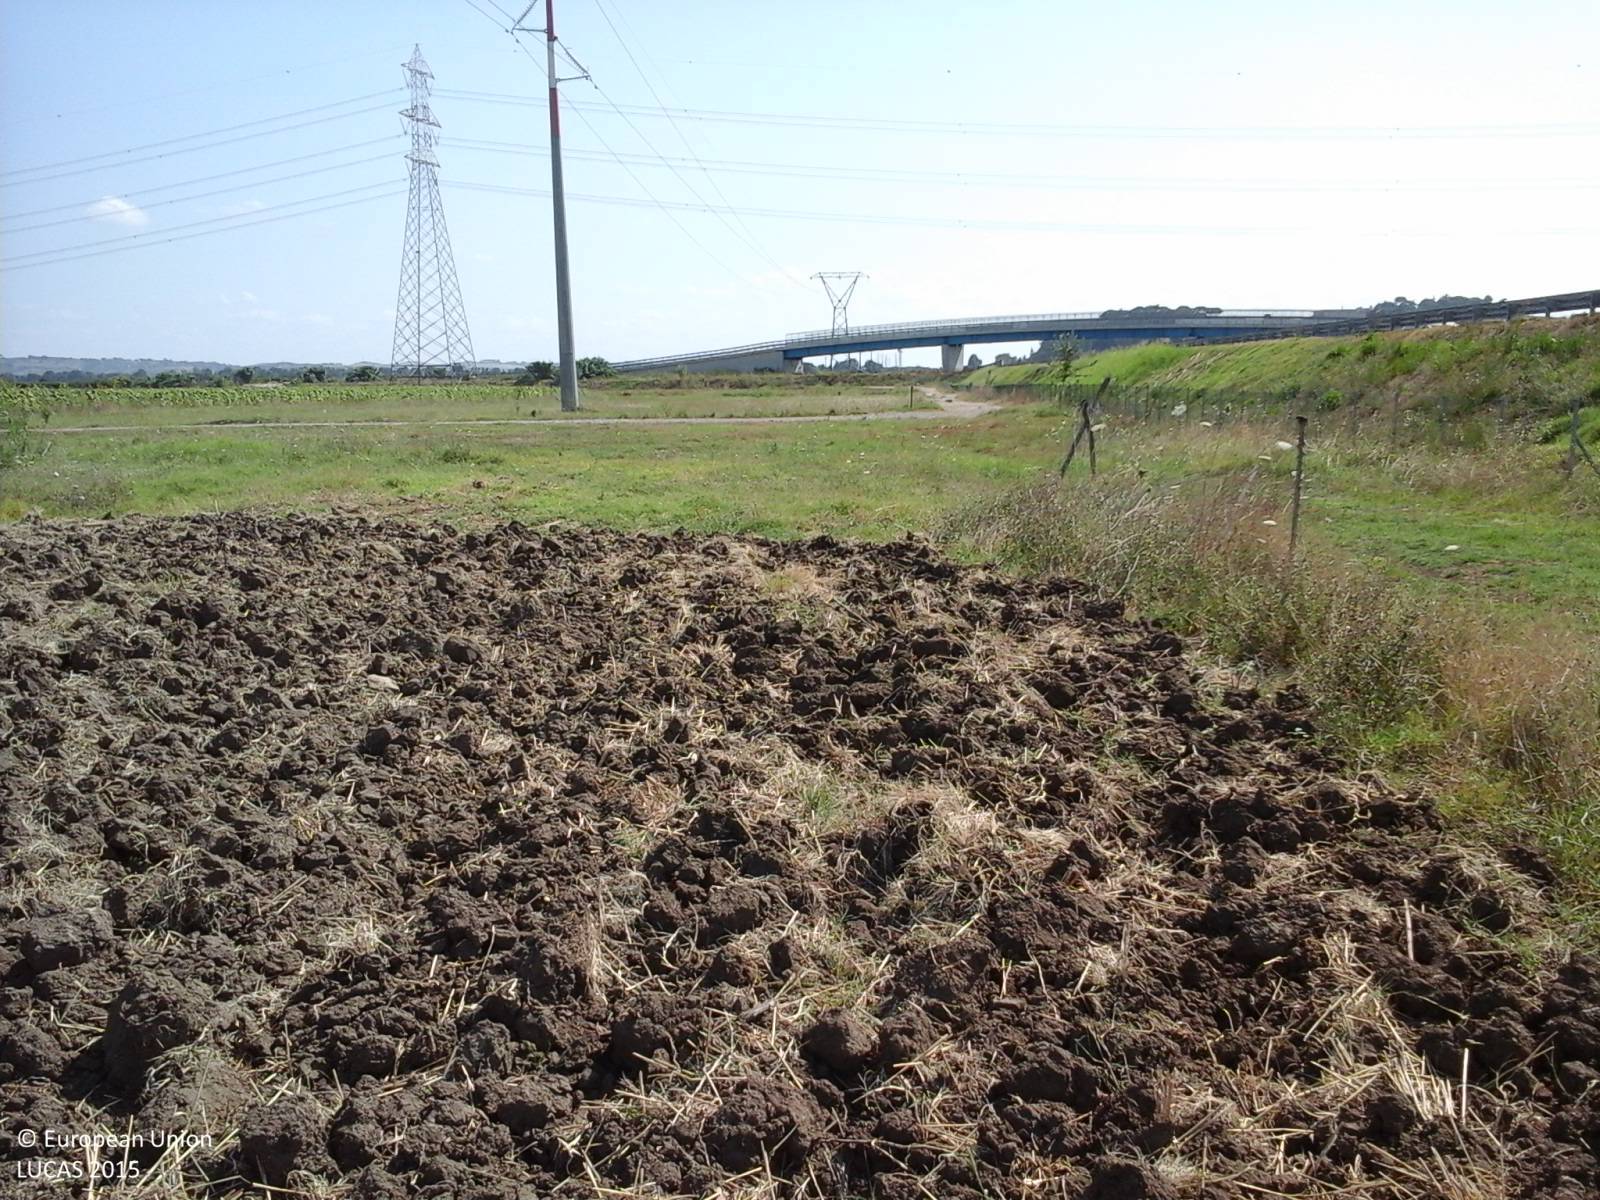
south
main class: Cropland
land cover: Durum wheat
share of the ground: < 10 %
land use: Agriculture (excluding fallow land and kitchen gardens)
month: July
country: IT
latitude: 42.1148
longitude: 12.5911
